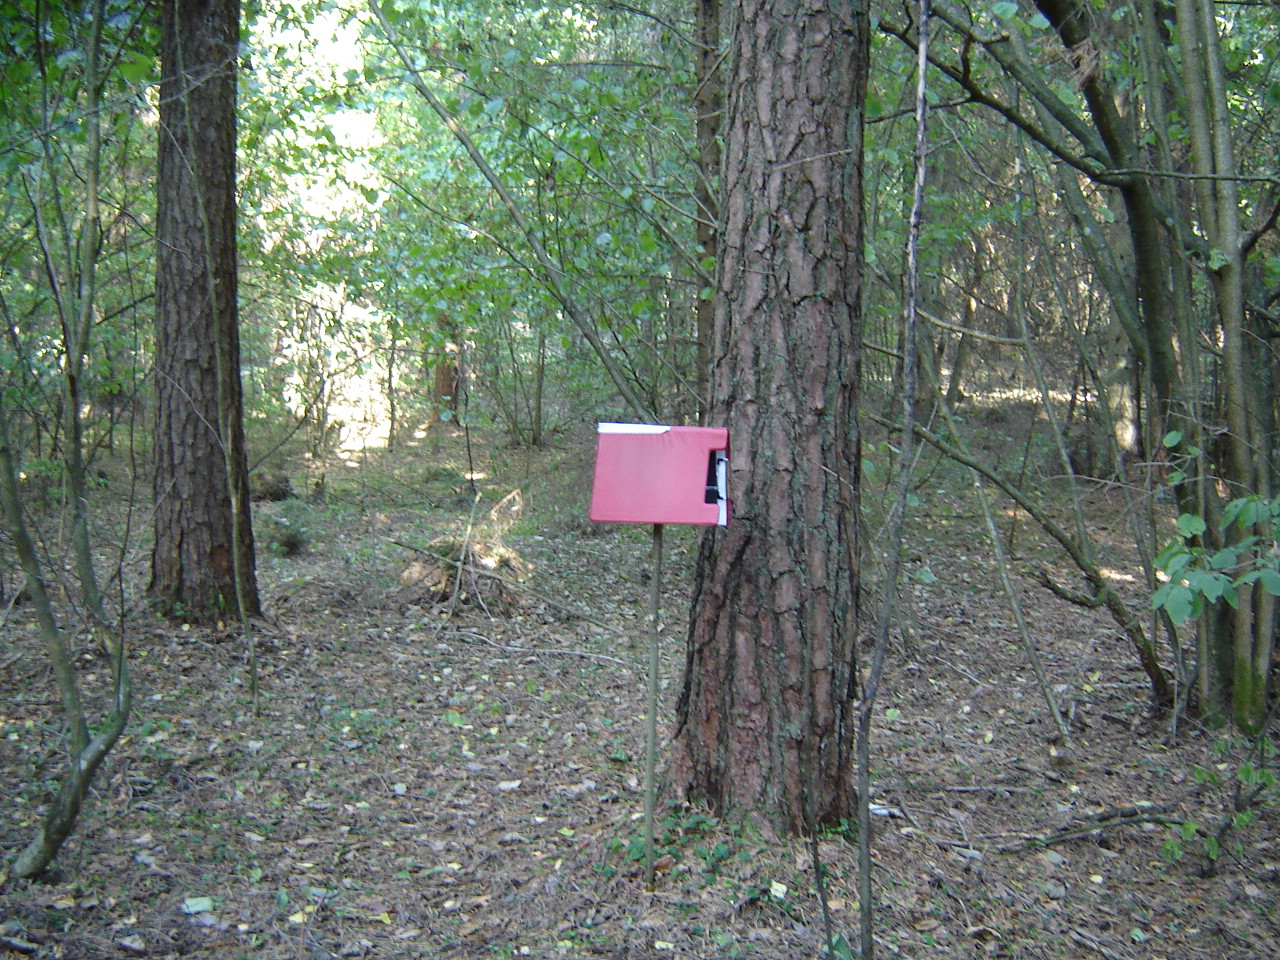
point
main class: Woodland
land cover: Pine dominated mixed woodland
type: hemiboreal forest and nemoral coniferous forest and mixed broadleaved-coniferous forest
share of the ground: > 75 %
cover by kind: coniferous forest trees 65 %, broadleaved forest trees 30 %, unconsolidated bare surface 5 %
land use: Forestry
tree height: > 5 m
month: August
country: LT
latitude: 54.5242
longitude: 24.7401
